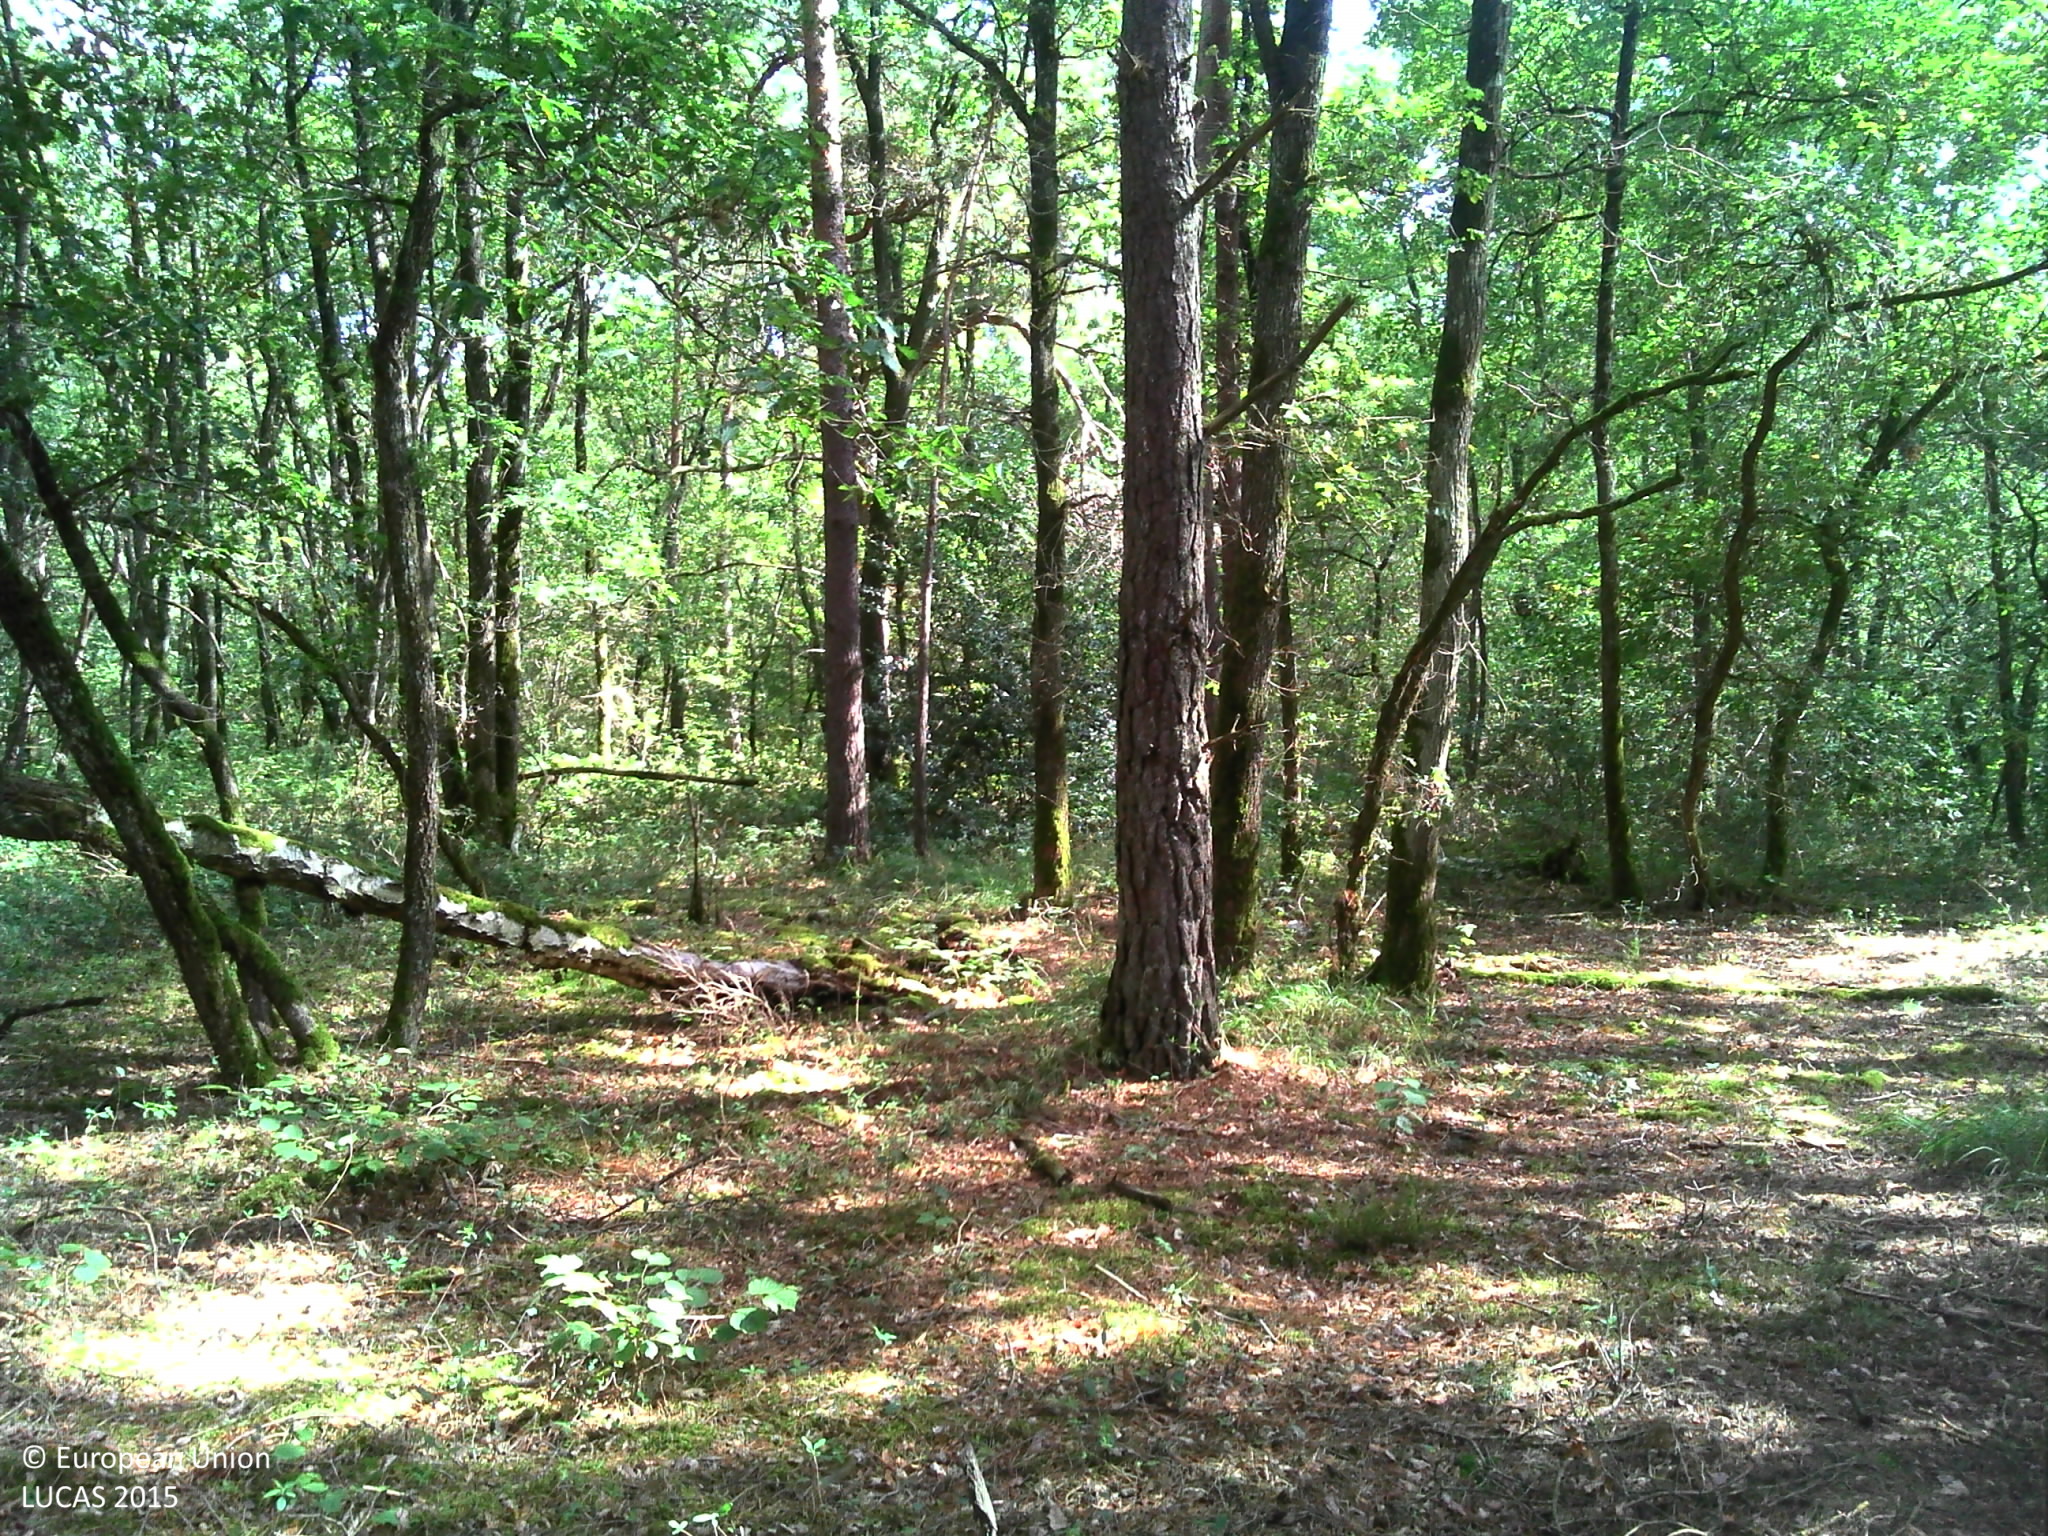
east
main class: Woodland
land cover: Pine dominated mixed woodland
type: acidophilous oak and oak-birch forest
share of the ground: > 75 %
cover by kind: coniferous forest trees 50 %, broadleaved forest trees 40 %, herbaceous plants 5 %, lichens and mosses 5 %
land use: Forestry
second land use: Amenities, museums, leisure
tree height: > 5 m
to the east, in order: Pine dominated mixed woodland; Broadleaved woodland; Tracks; Broadleaved woodland
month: September
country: FR
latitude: 48.2383
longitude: 2.7608
